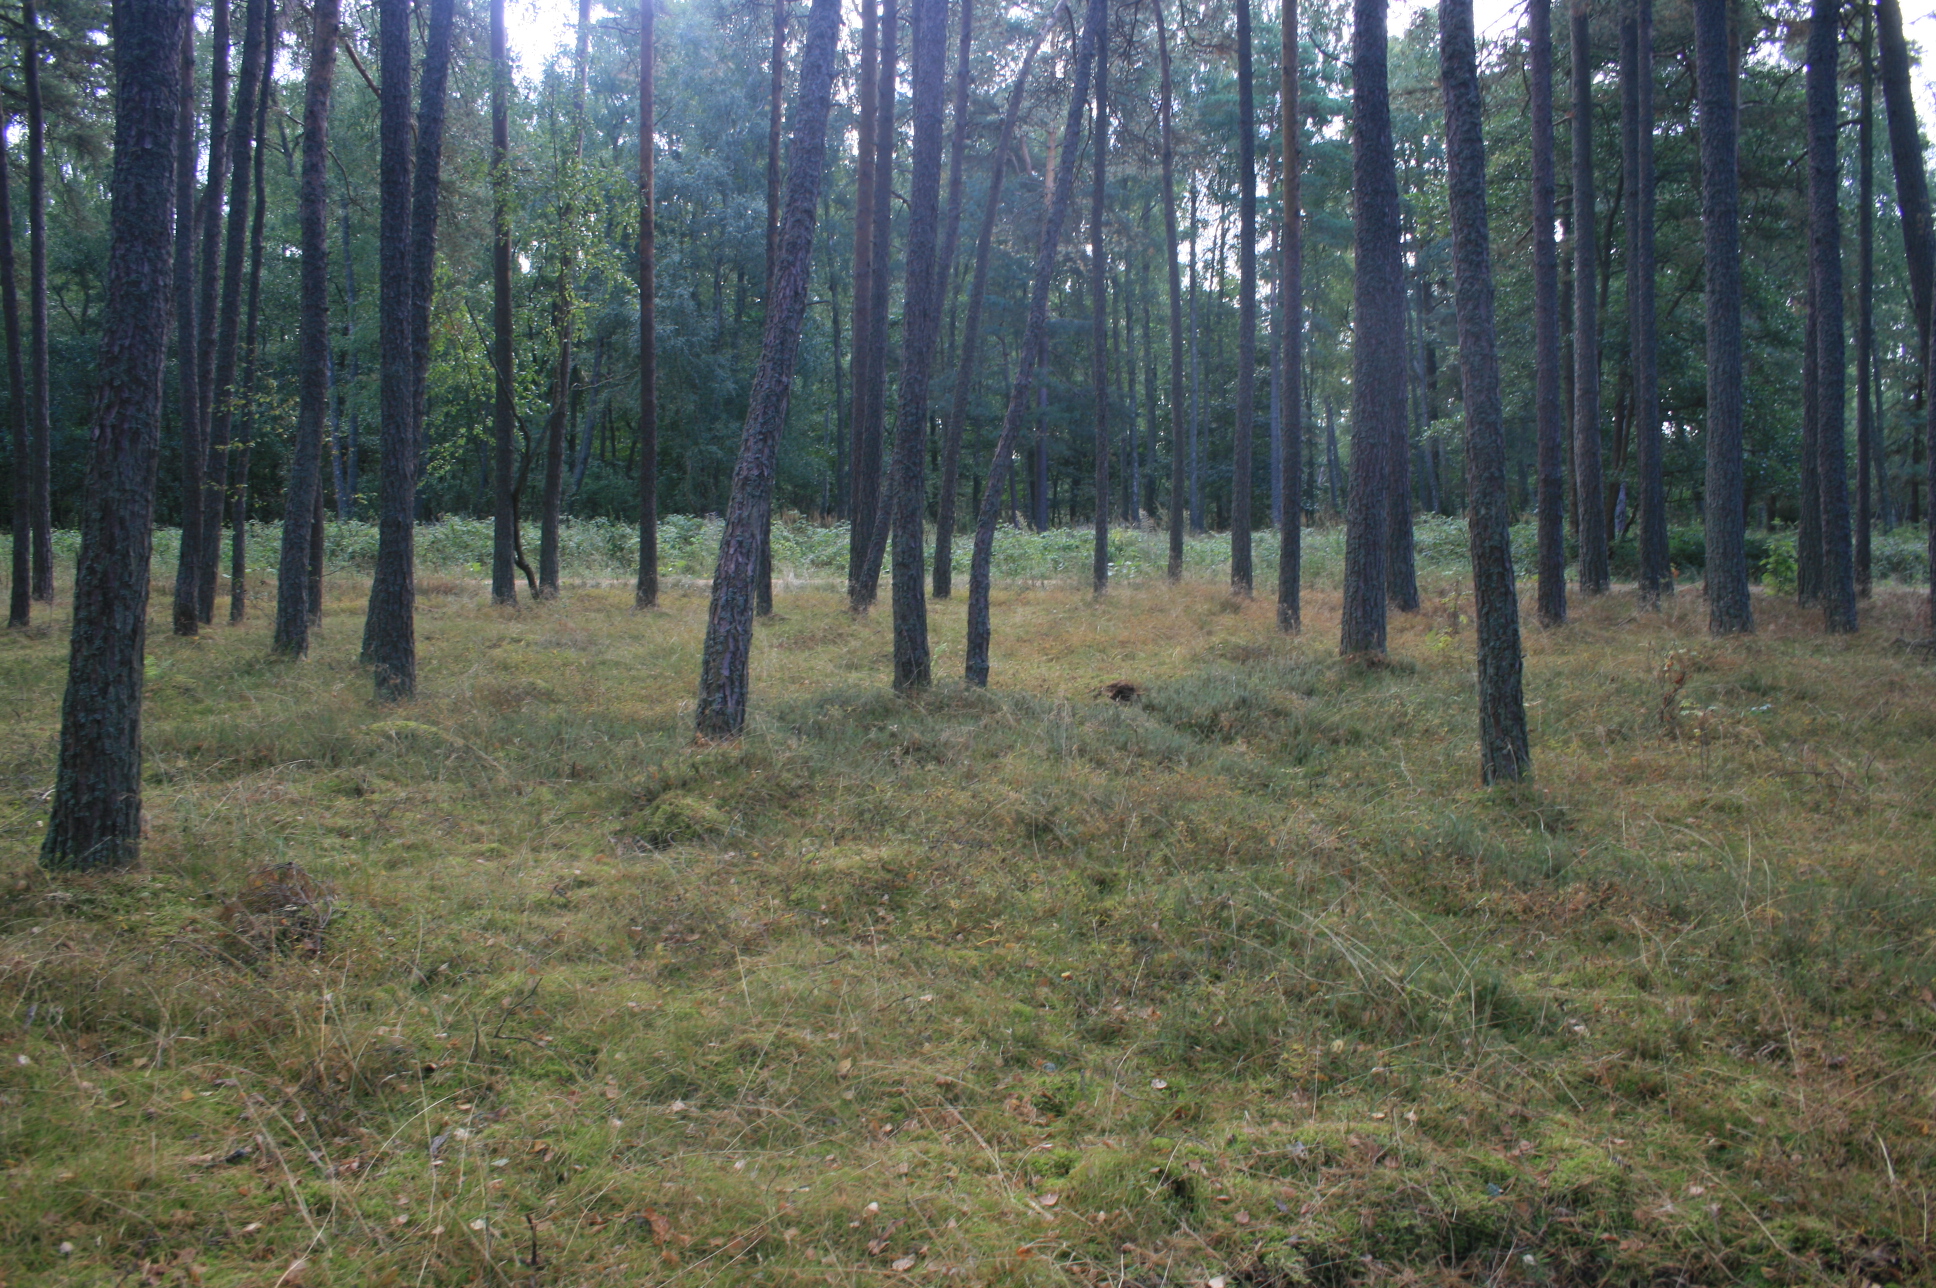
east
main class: Woodland
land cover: Pine dominated coniferous woodland
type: hemiboreal forest and nemoral coniferous forest and mixed broadleaved-coniferous forest
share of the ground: > 75 %
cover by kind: coniferous forest trees 80 %, herbaceous plants 10 %, lichens and mosses 10 %
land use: Forestry
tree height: > 5 m
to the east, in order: Pine dominated coniferous woodland; Shruby margins; Paved roads, cycling and walking lanes; Shrubland without tree cover; Other bare soil; Shruby margins; Other mixed woodland; Pine dominated mixed woodland; Pine dominated coniferous woodland; Spontaneously vegetated surfaces; Pine dominated coniferous woodland
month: September
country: LT
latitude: 55.3978
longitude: 21.0775
